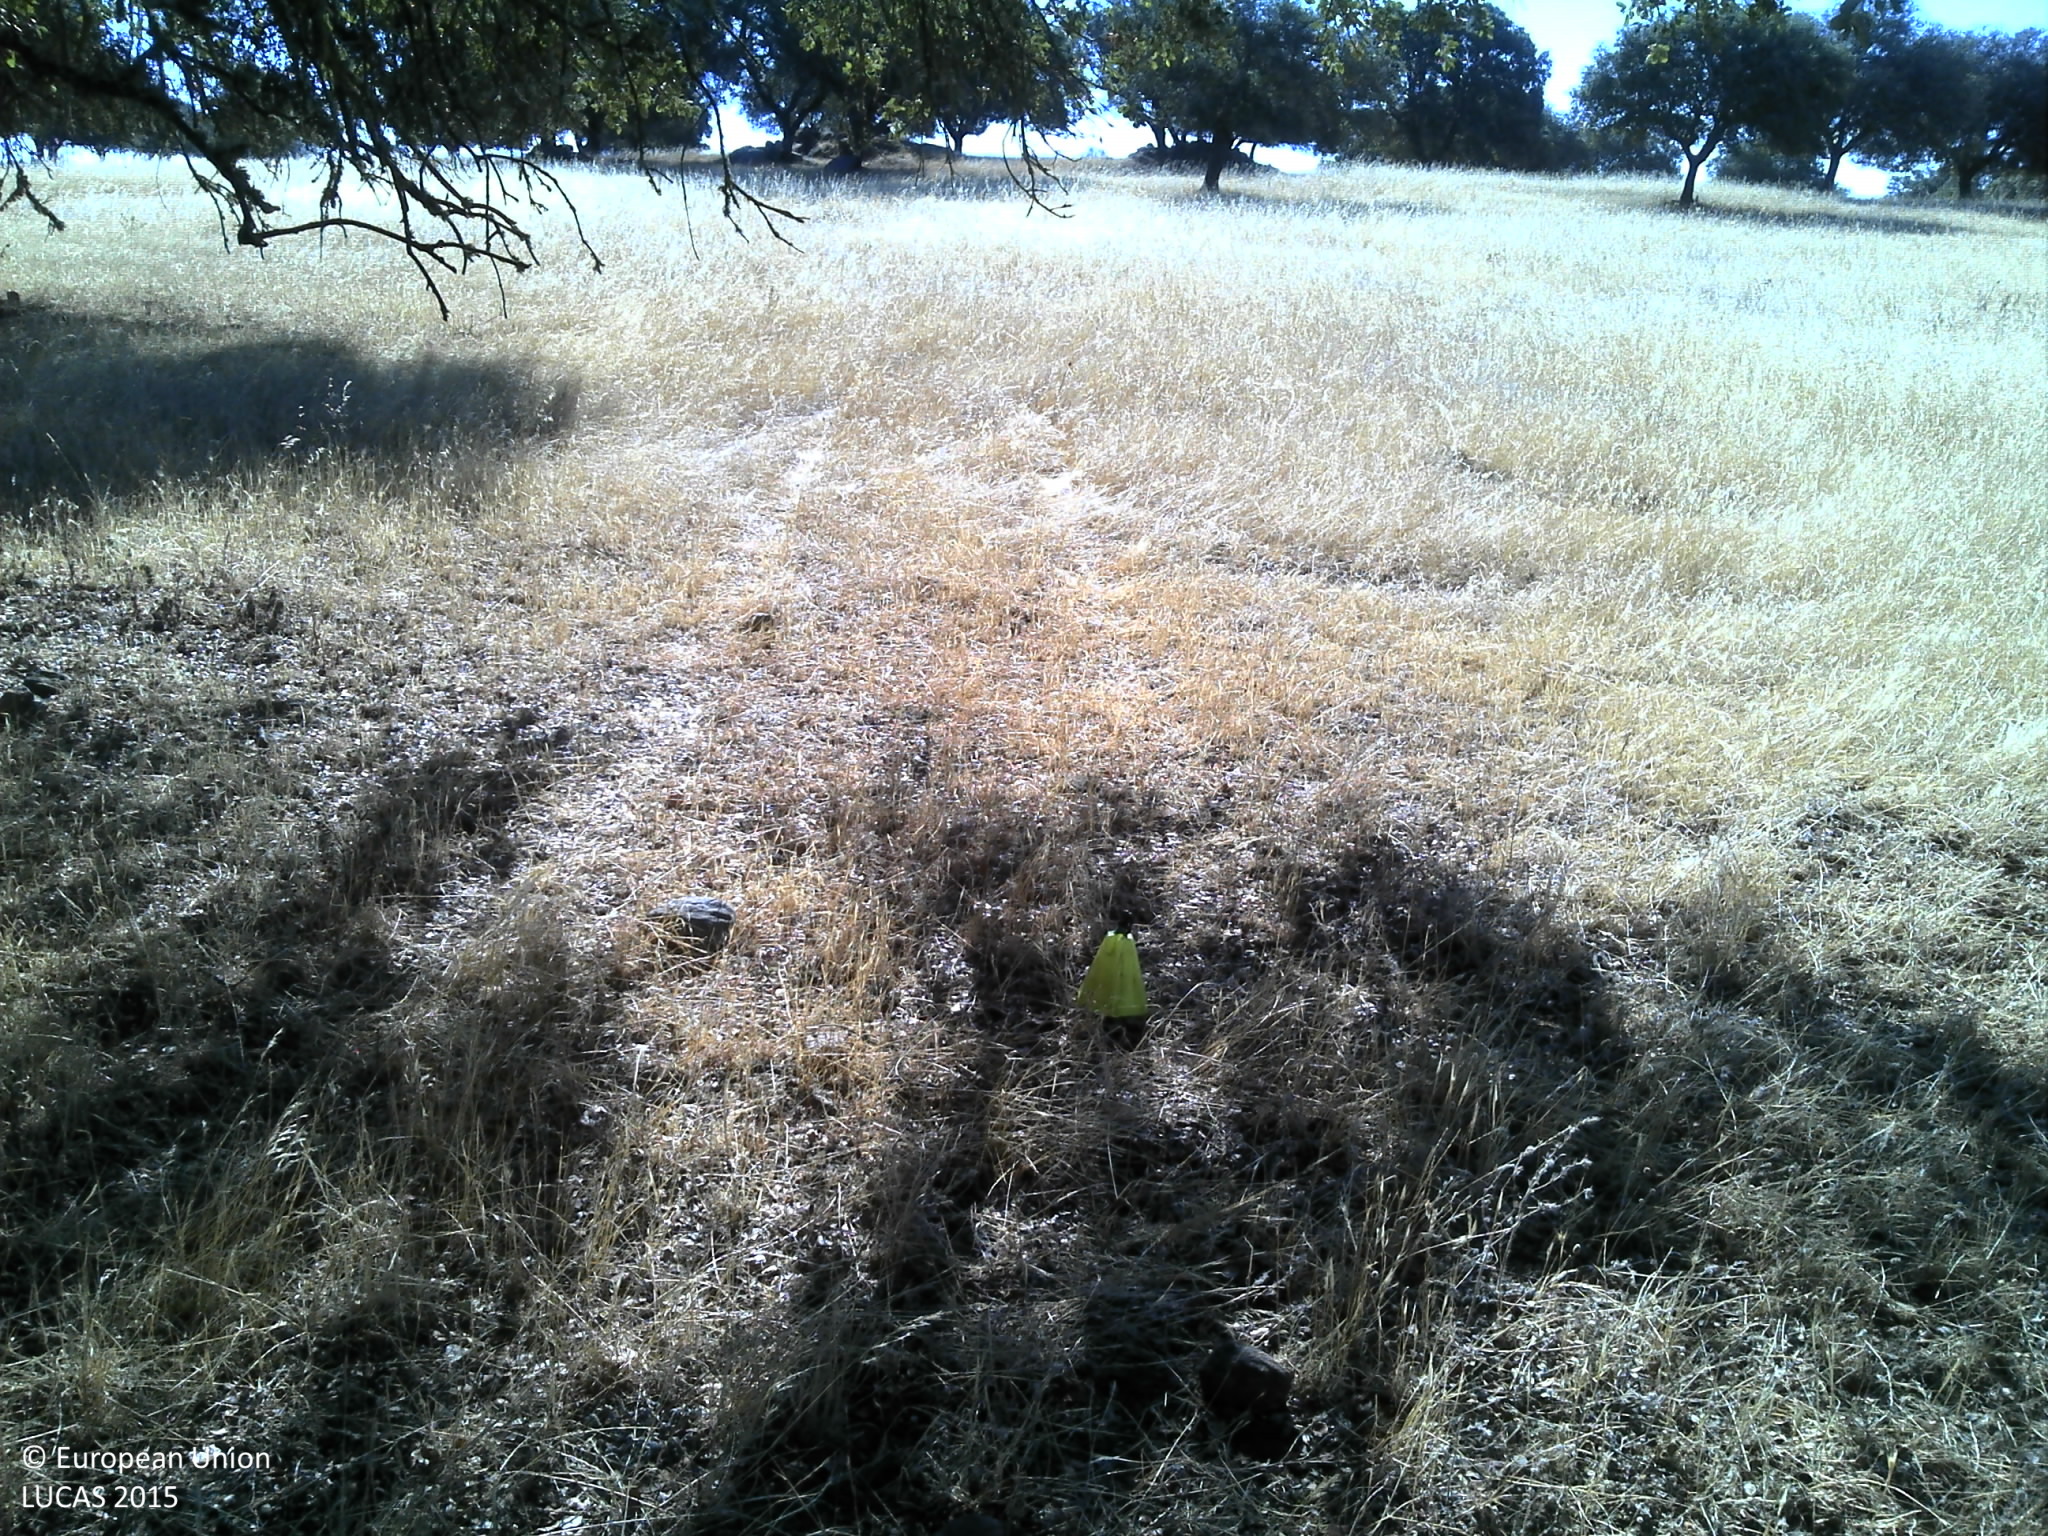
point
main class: Woodland
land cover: Broadleaved woodland
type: broadleaved evergreen forest
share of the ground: 10 - 25 %
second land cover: Grassland without tree/shrub cover
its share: 50 - 75 %
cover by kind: herbaceous plants 60 %, unconsolidated bare surface 25 %, broadleaved forest trees 15 %
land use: Forestry
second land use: Agriculture (excluding fallow land and kitchen gardens)
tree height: > 5 m
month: July
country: PT
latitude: 38.9612
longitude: -7.3795
